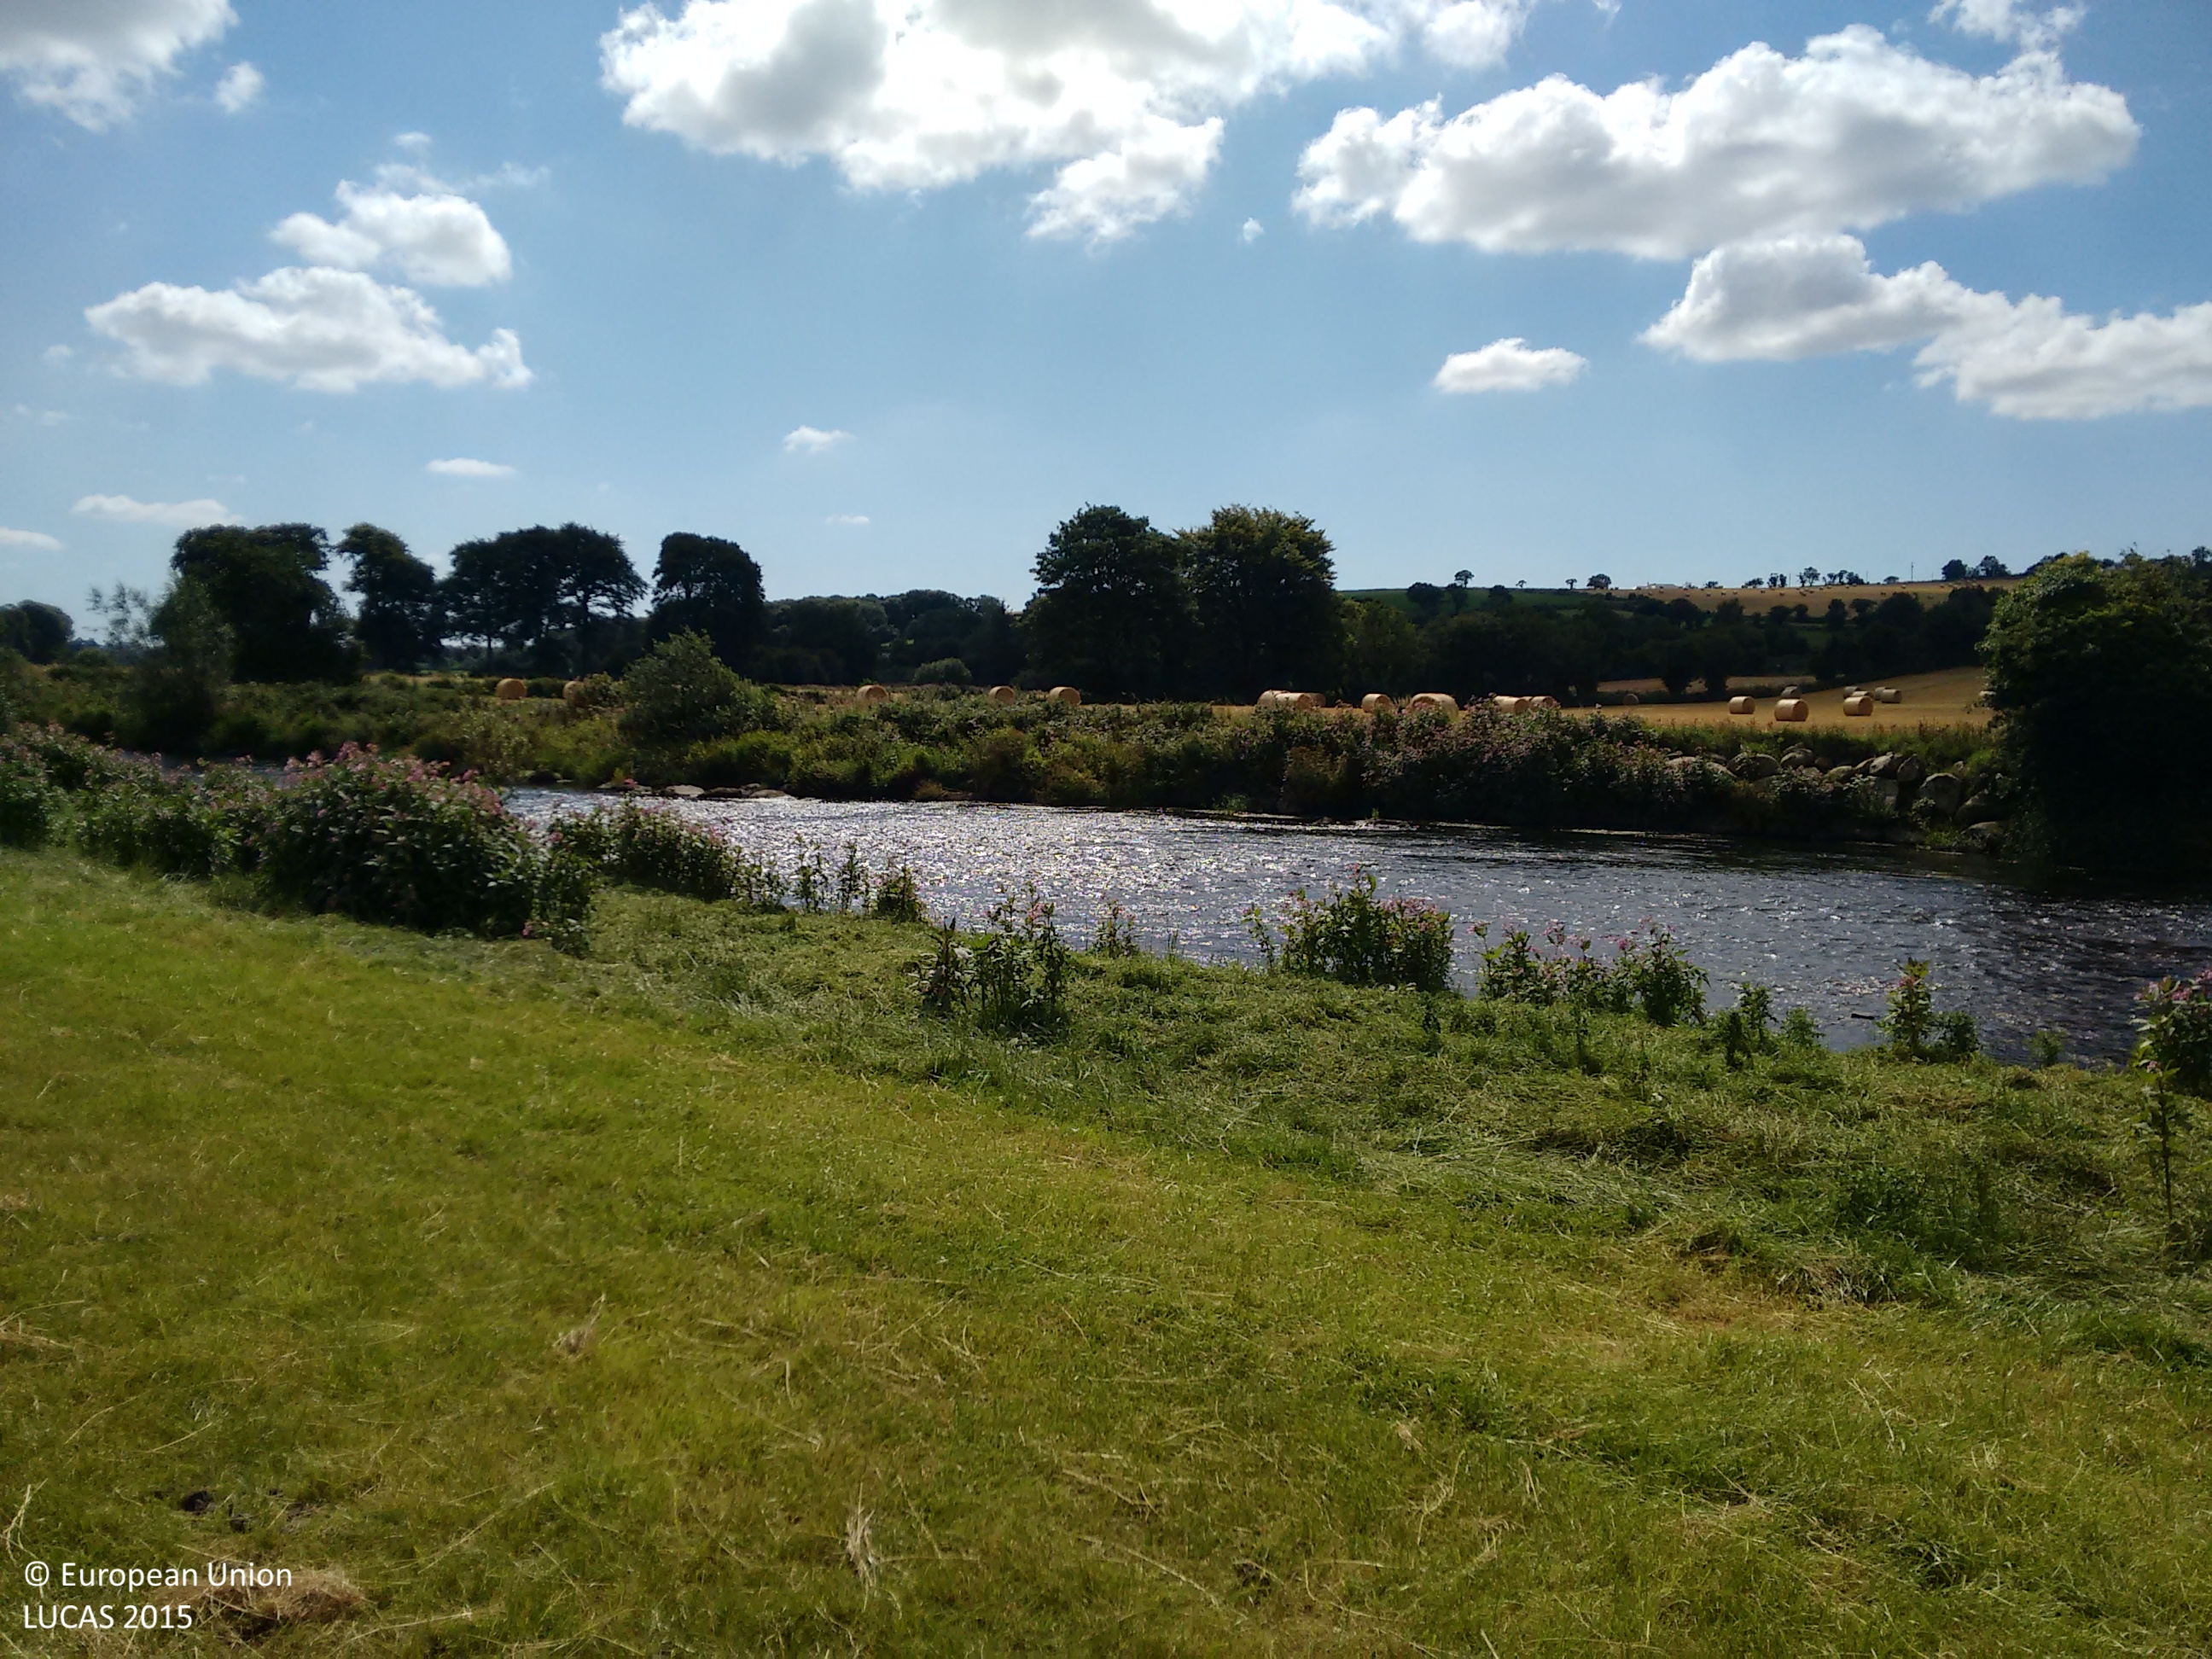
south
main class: Grassland
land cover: Grassland without tree/shrub cover
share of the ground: > 75 %
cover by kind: herbaceous plants 100 %
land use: Agriculture (excluding fallow land and kitchen gardens)
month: August
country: IE
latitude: 52.6123
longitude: -6.5974
